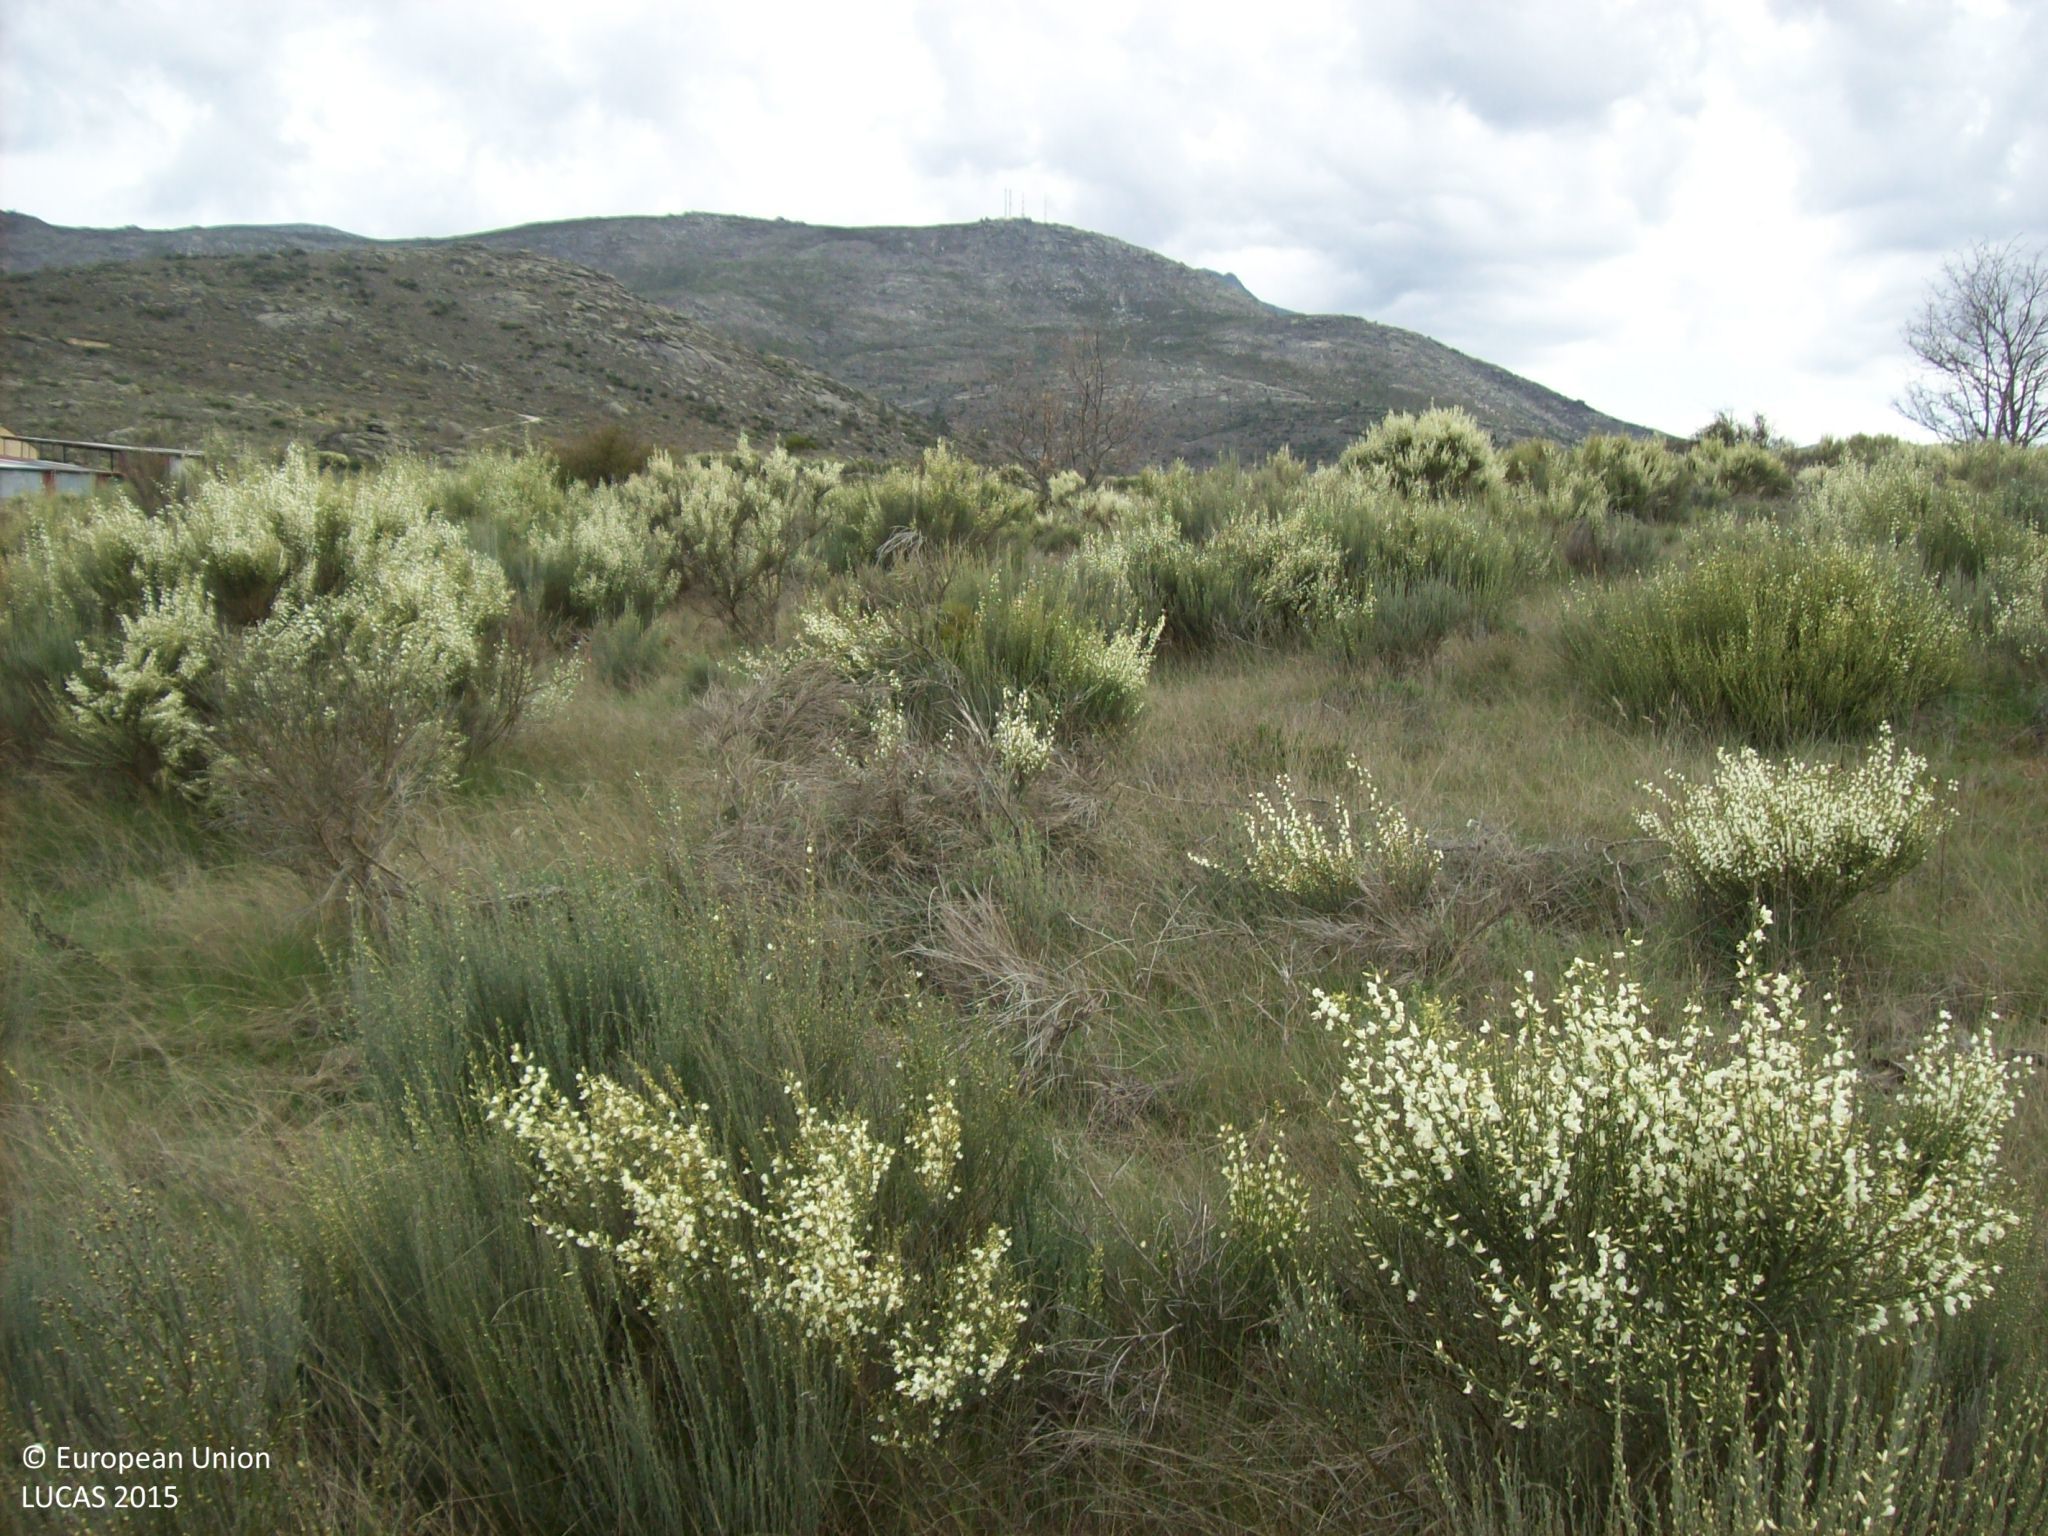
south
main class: Shrubland
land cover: Shrubland with sparse tree cover
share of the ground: > 75 %
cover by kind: shrubs 60 %, herbaceous plants 20 %, broadleaved forest trees 5 %
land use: Semi-natural and natural areas not in use
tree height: < 5 m
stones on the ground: < 10 %
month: April
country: ES
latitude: 40.3735
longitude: -4.8827
